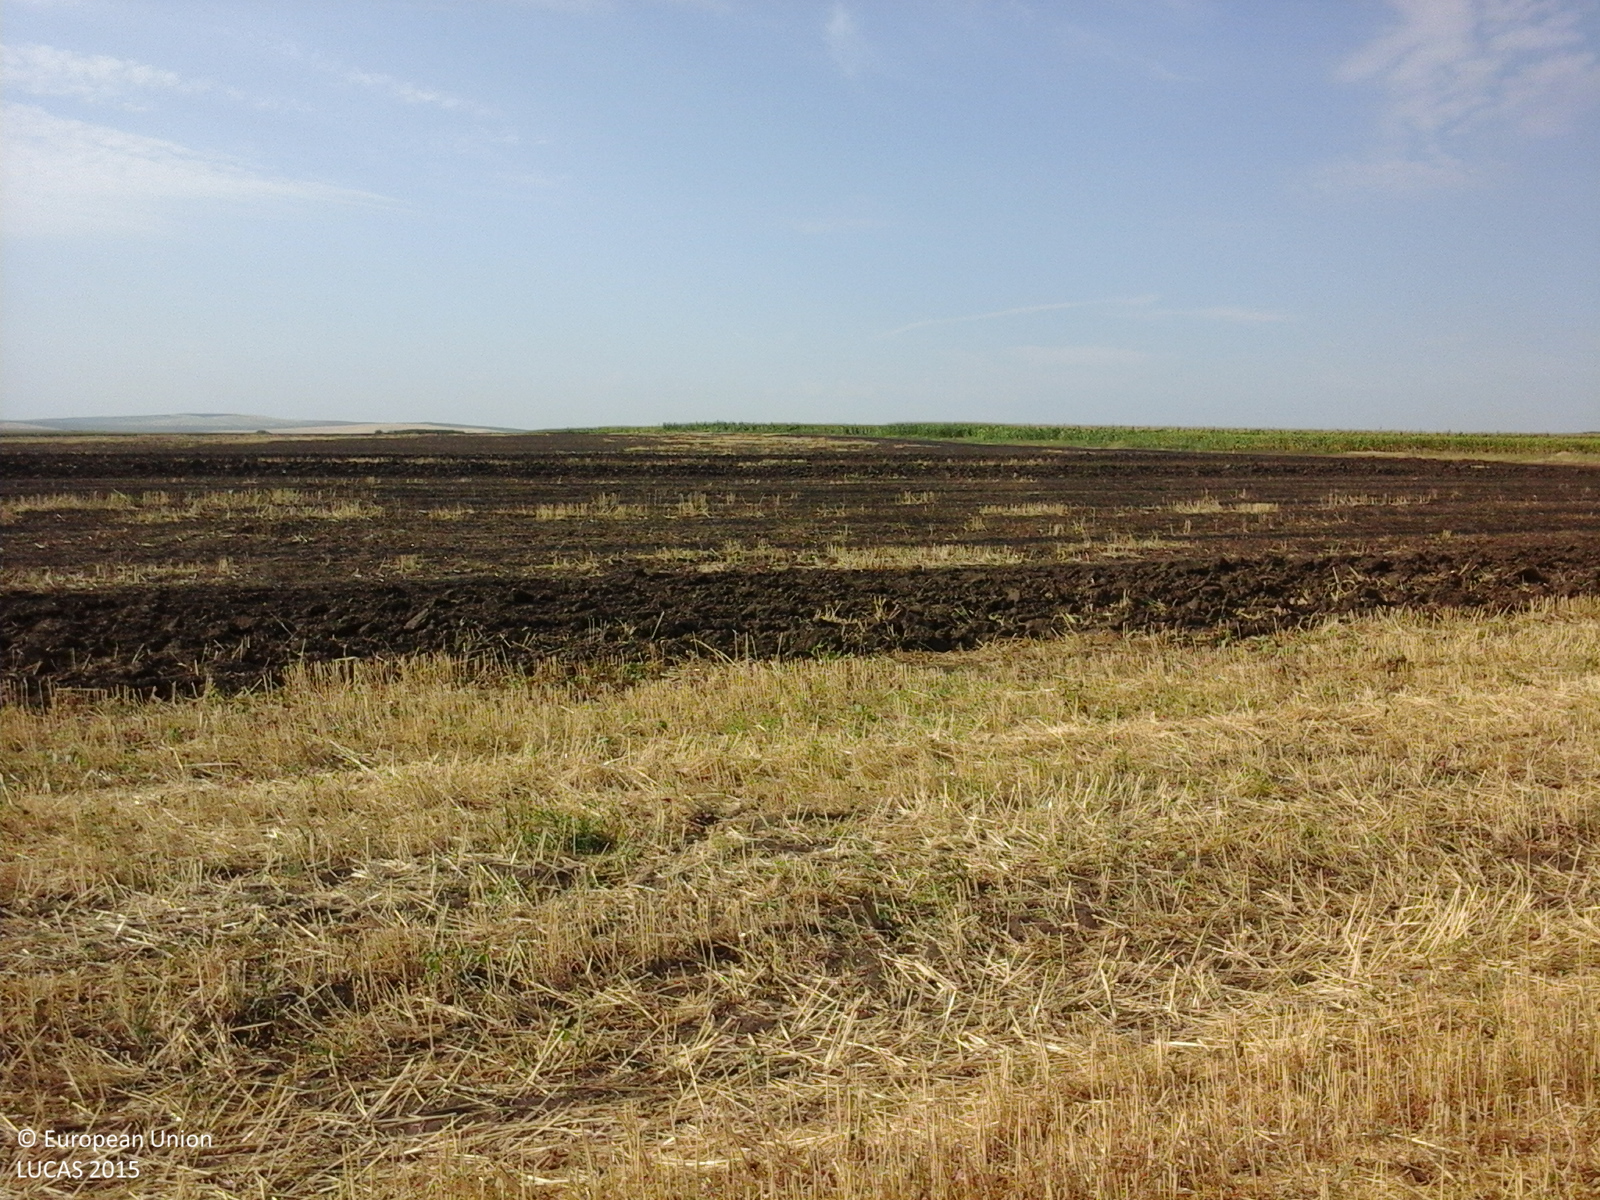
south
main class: Cropland
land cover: Common wheat
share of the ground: > 75 %
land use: Agriculture (excluding fallow land and kitchen gardens)
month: July
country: RO
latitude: 46.1485
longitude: 28.0303
